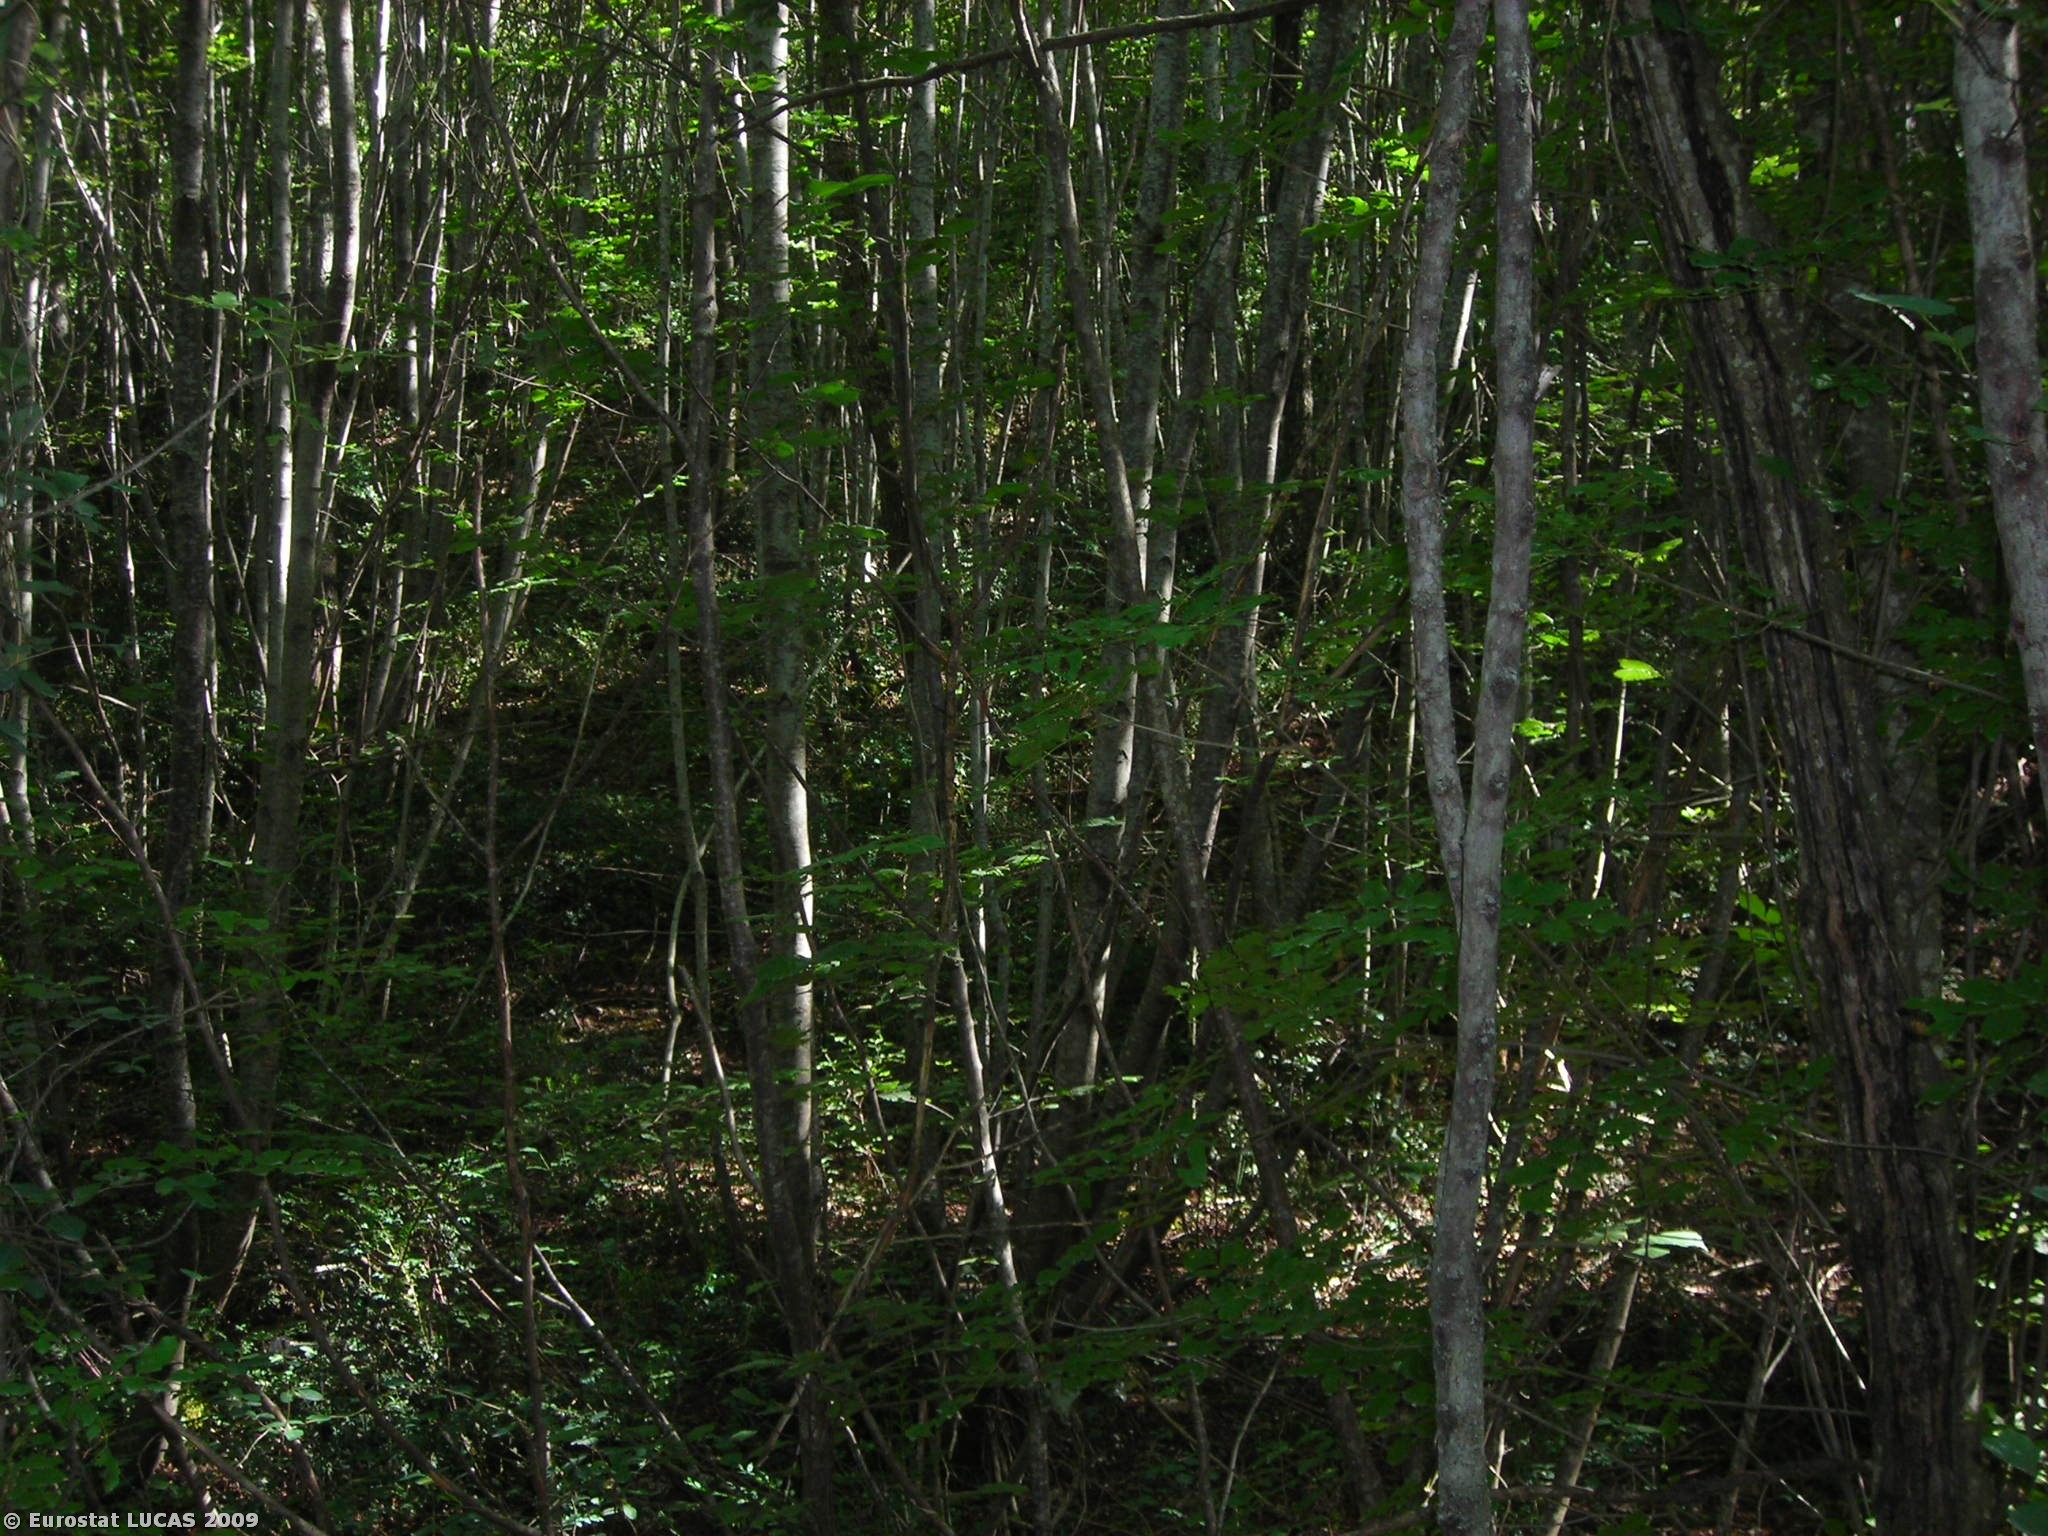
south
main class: Woodland
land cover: Broadleaved woodland
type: thermophilous deciduous forest
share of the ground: > 75 %
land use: Forestry
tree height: > 5 m
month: July
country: IT
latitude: 43.3071
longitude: 13.2339
